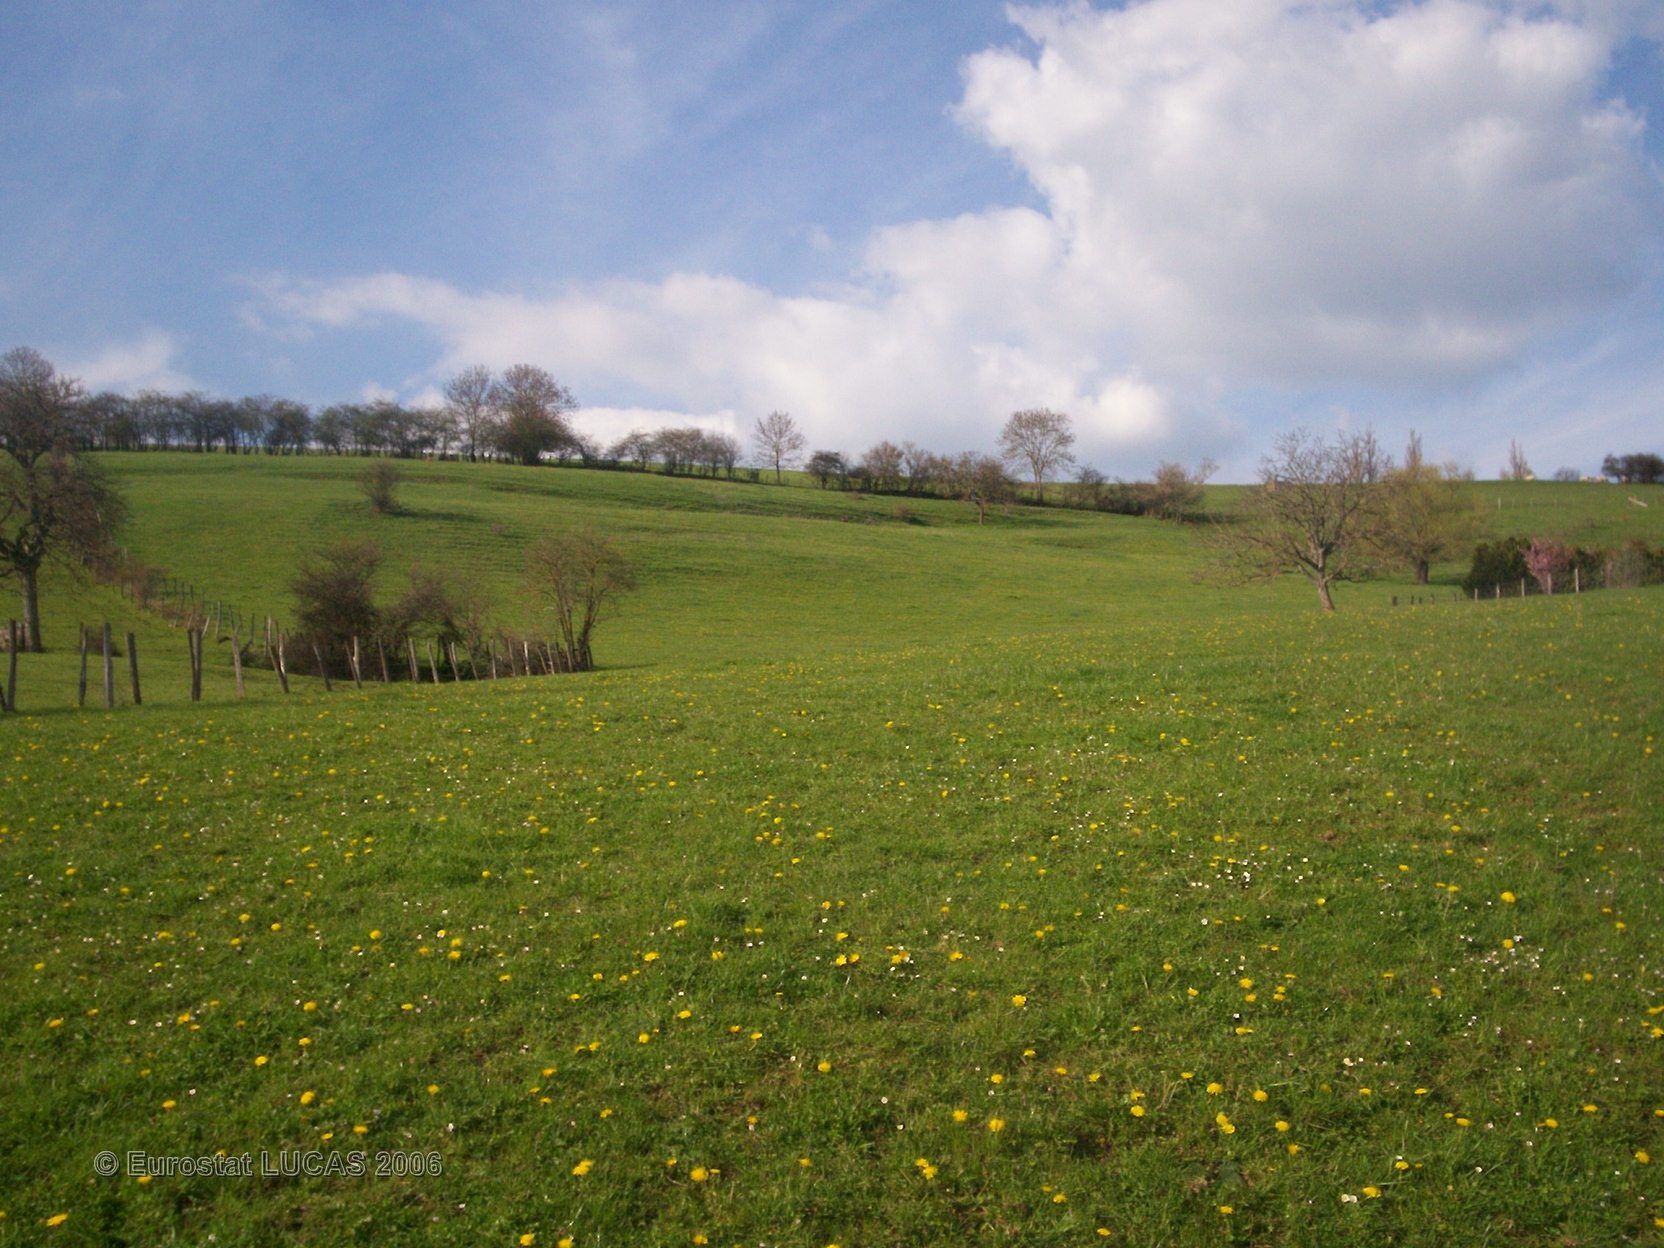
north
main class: Grassland
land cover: Grassland without tree/shrub cover
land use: Agriculture (excluding fallow land and kitchen gardens)
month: April
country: FR
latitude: 46.2260
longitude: 4.1280
